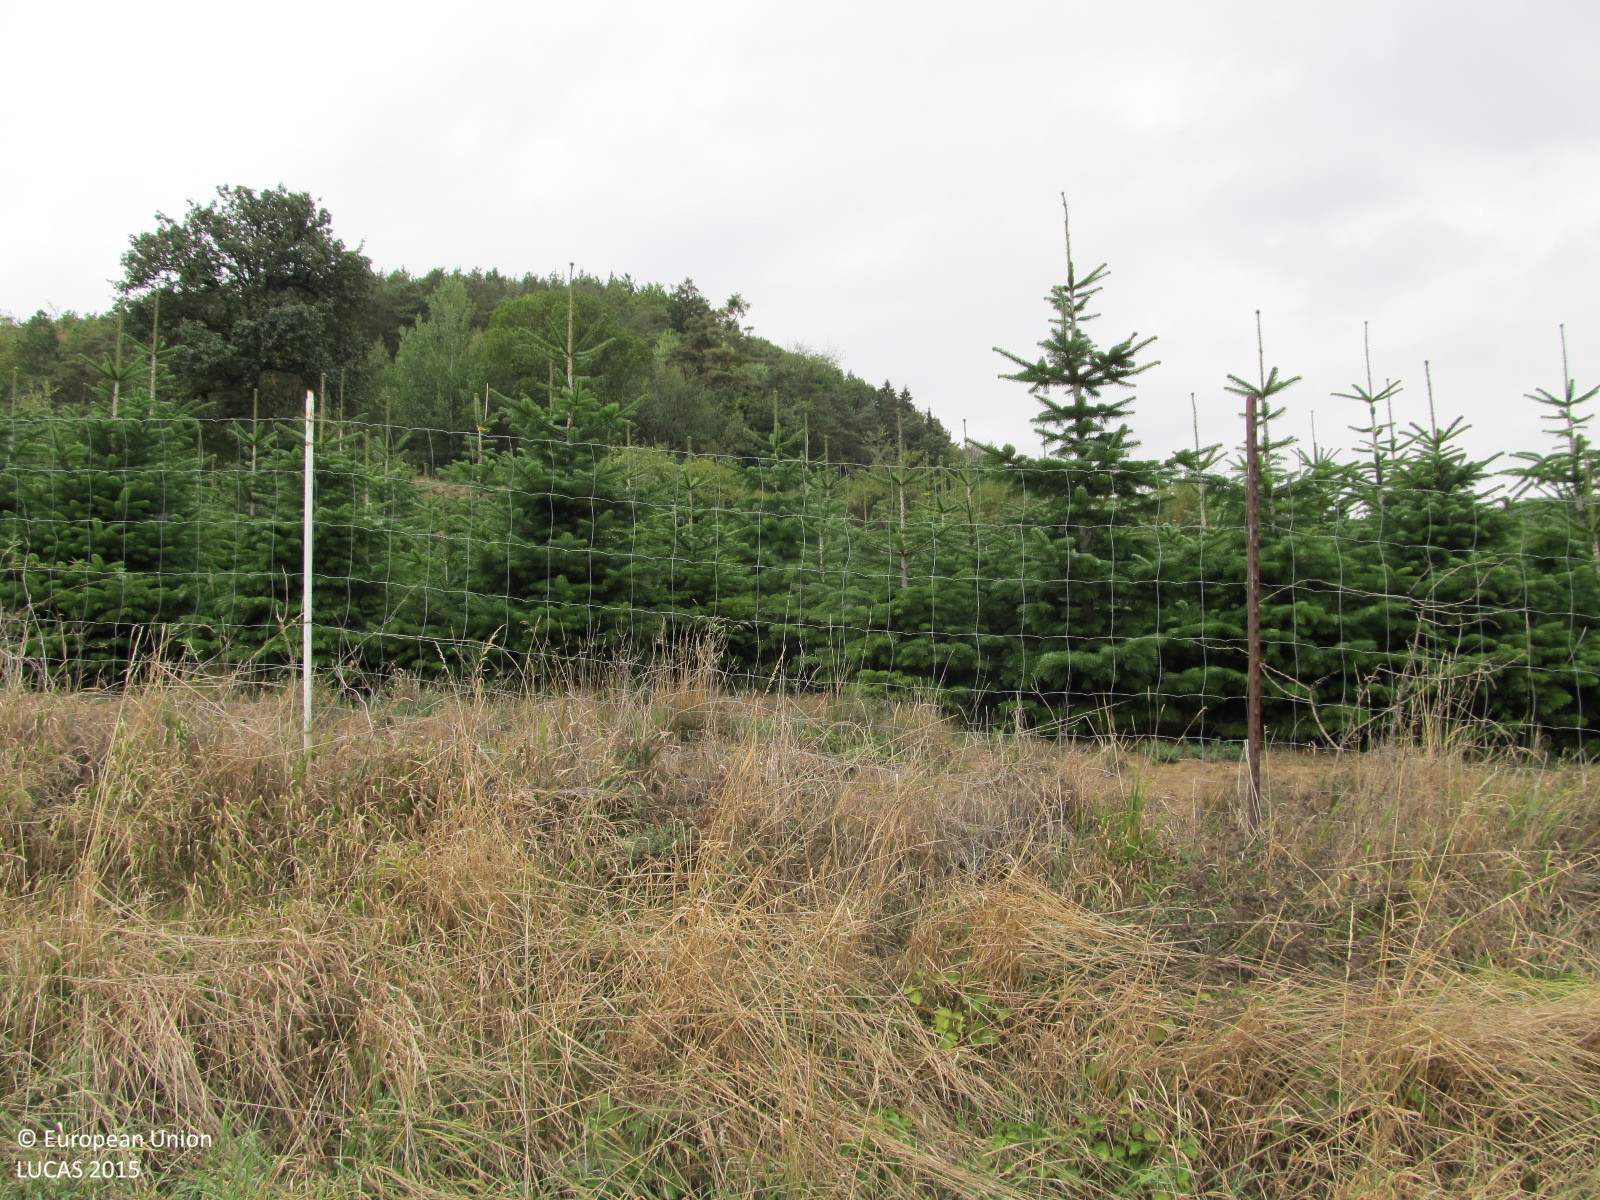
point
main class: Woodland
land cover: Spruce dominated coniferous woodland
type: hemiboreal forest and nemoral coniferous forest and mixed broadleaved-coniferous forest
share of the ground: > 75 %
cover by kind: coniferous forest trees 85 %, herbaceous plants 15 %
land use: Forestry
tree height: < 5 m
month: September
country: AT
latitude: 48.3663
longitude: 15.3069
